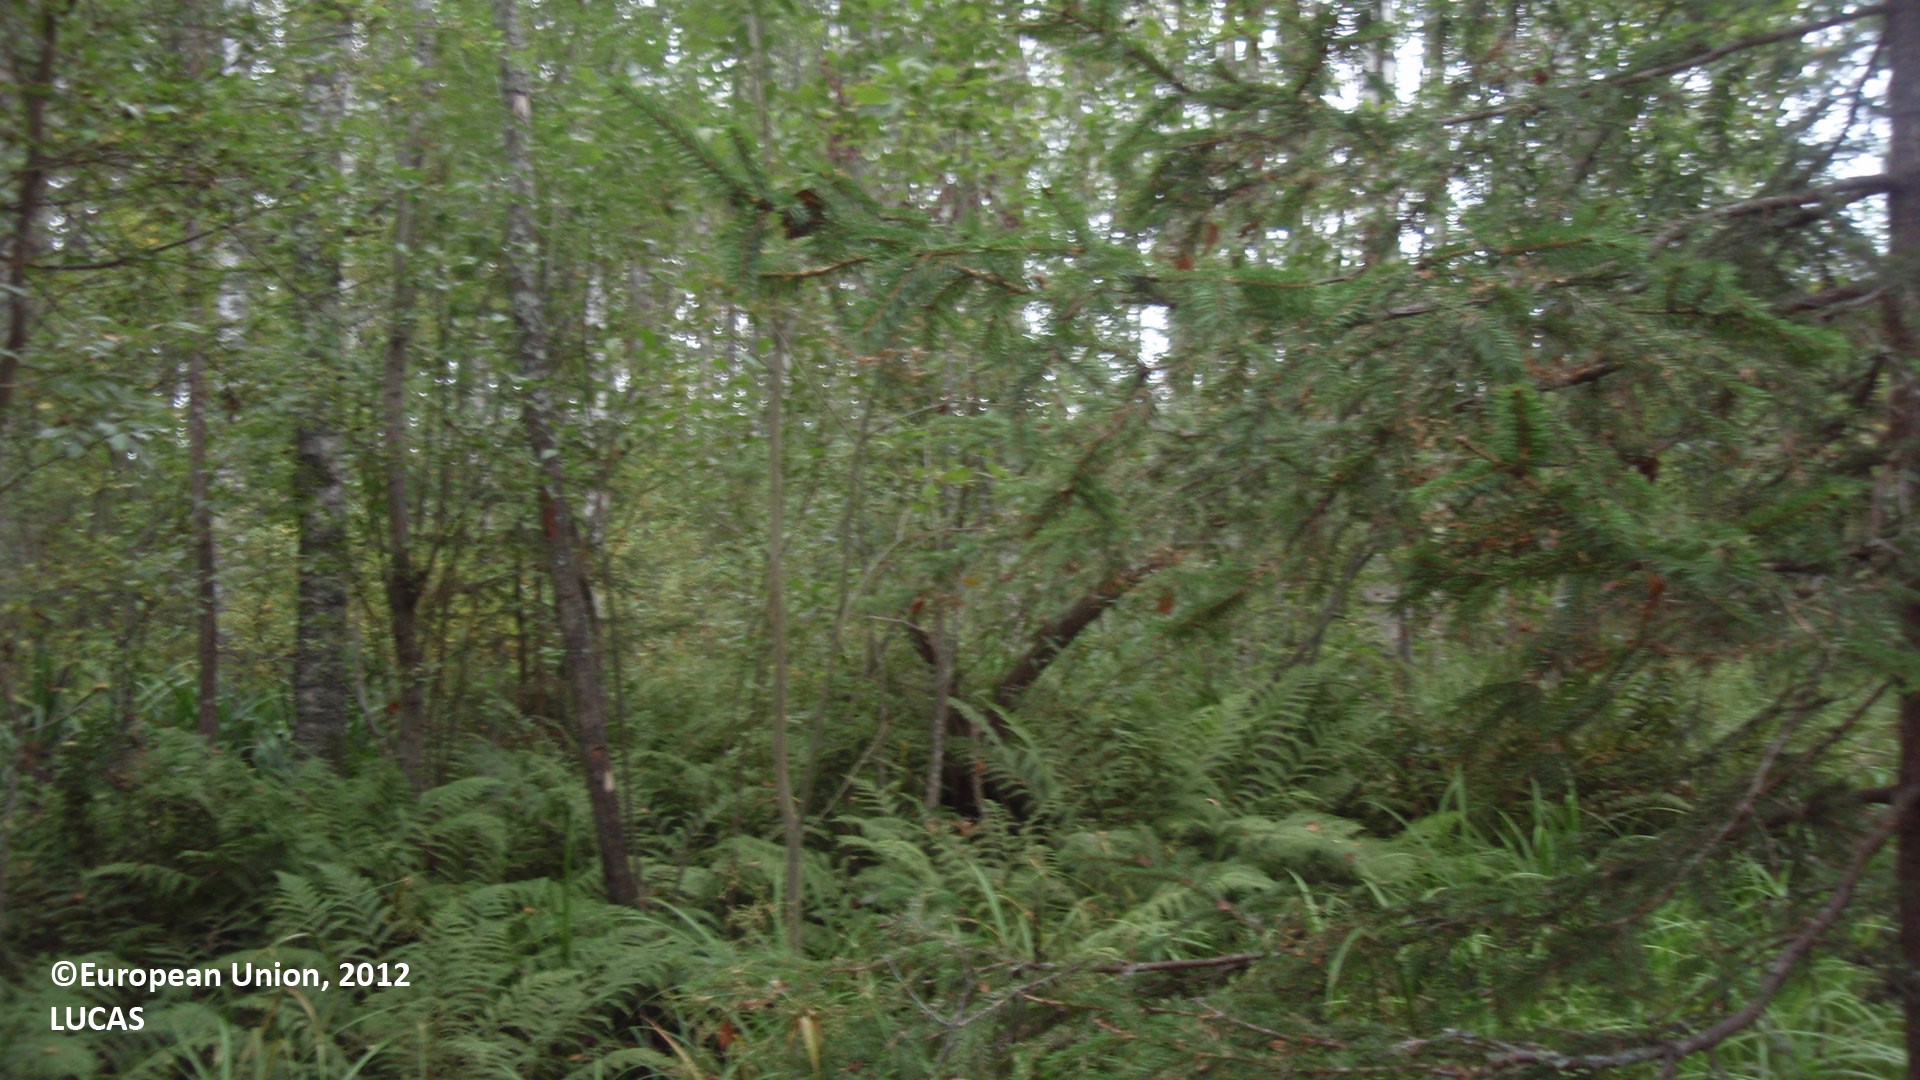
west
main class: Woodland
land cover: Broadleaved woodland
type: non-riverine alder, birch or aspen forest
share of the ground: > 75 %
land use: Forestry
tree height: > 5 m
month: August
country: FI
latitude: 61.0495
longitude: 26.6188
